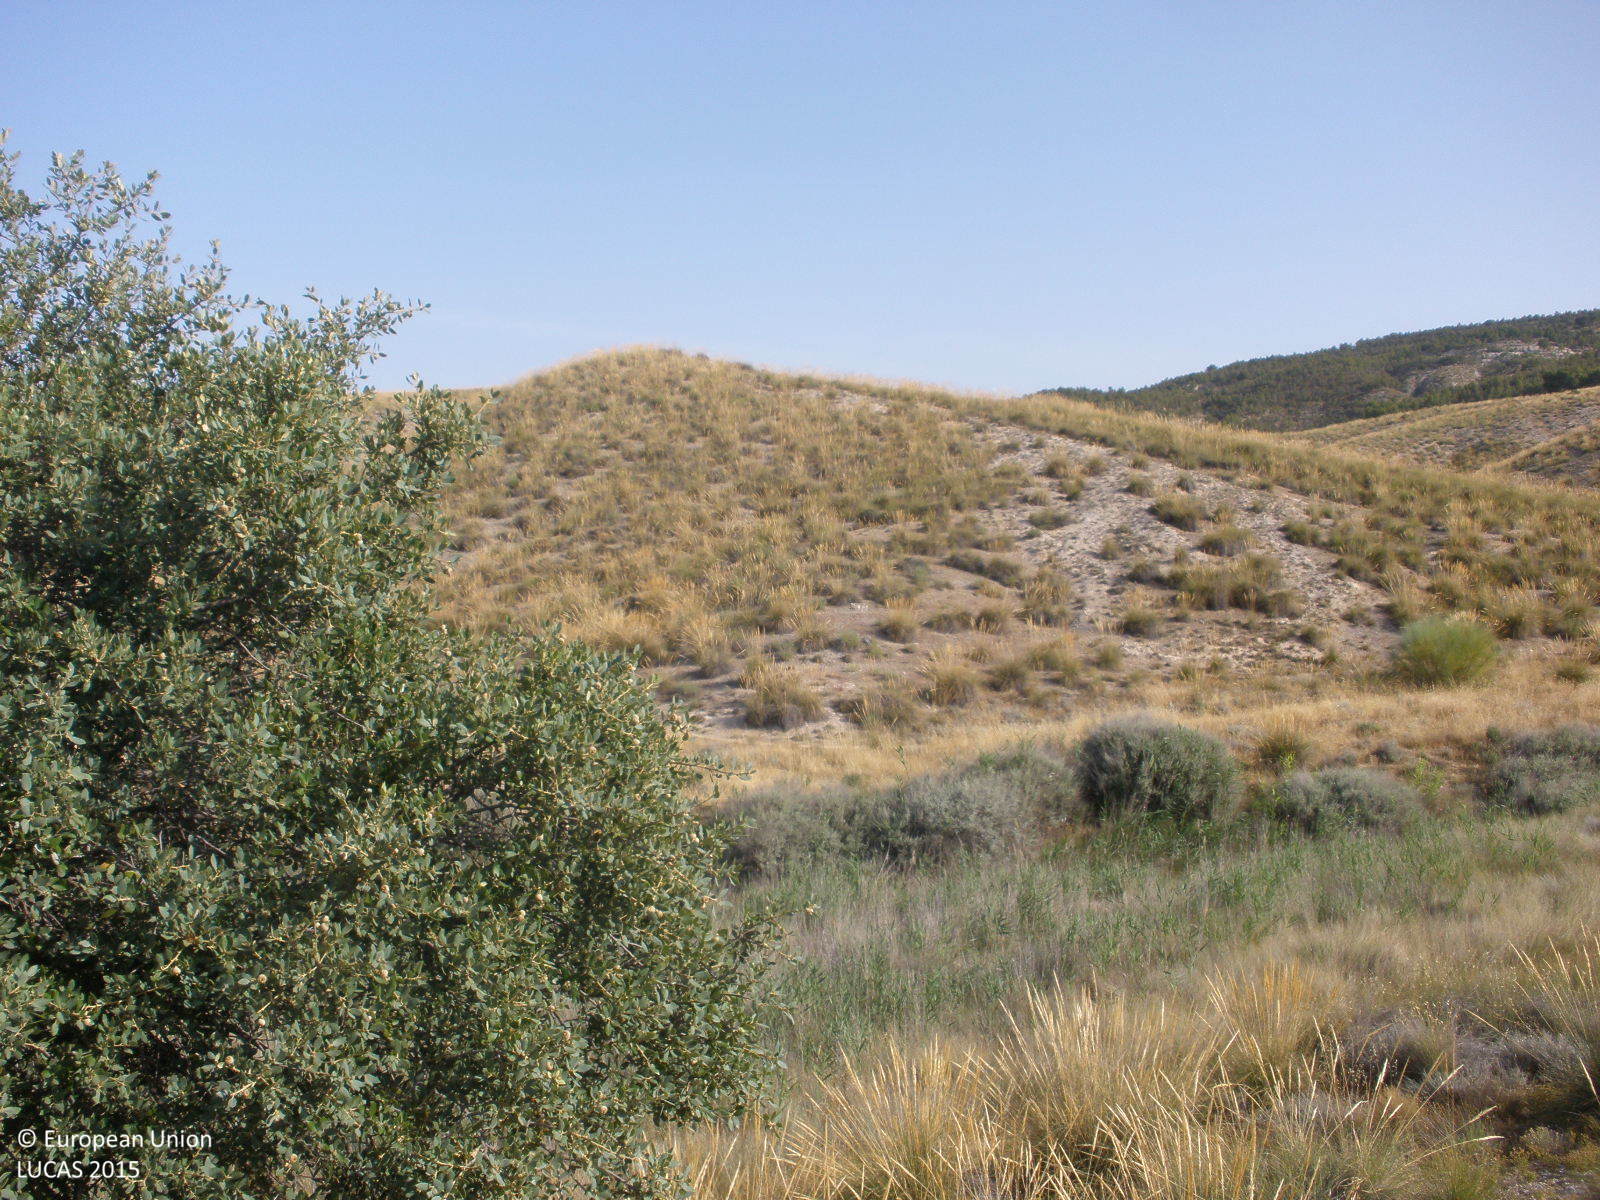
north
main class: Shrubland
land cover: Shrubland with sparse tree cover
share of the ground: 50 - 75 %
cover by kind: shrubs 45 %, herbaceous plants 35 %, consolidated bare surface 15 %, broadleaved forest trees 5 %
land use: Semi-natural and natural areas not in use
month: July
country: ES
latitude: 40.0570
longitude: -3.4050
